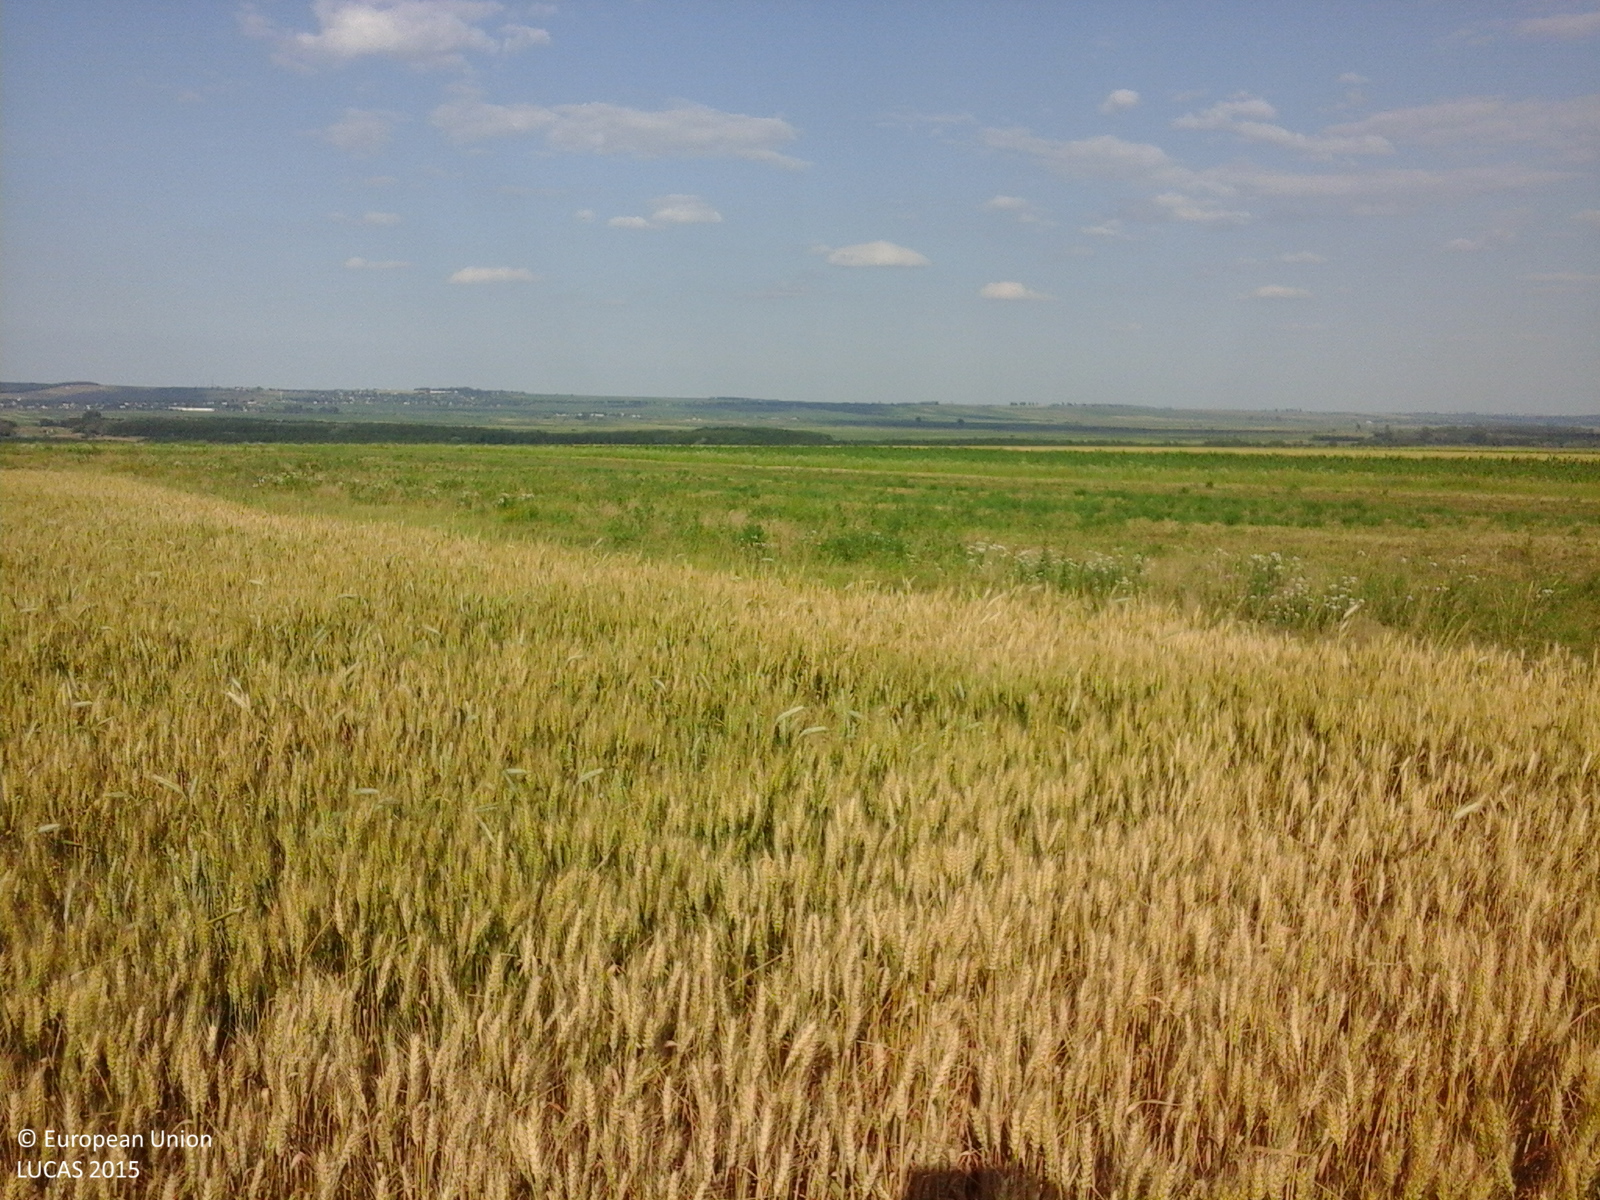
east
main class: Cropland
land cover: Common wheat
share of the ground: > 75 %
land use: Agriculture (excluding fallow land and kitchen gardens)
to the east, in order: Common wheat; Tracks; Other leguminous and mixtures for fodder; Maize; Lucerne; Grass margins; Common wheat
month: June
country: RO
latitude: 47.7414
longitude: 26.3705
